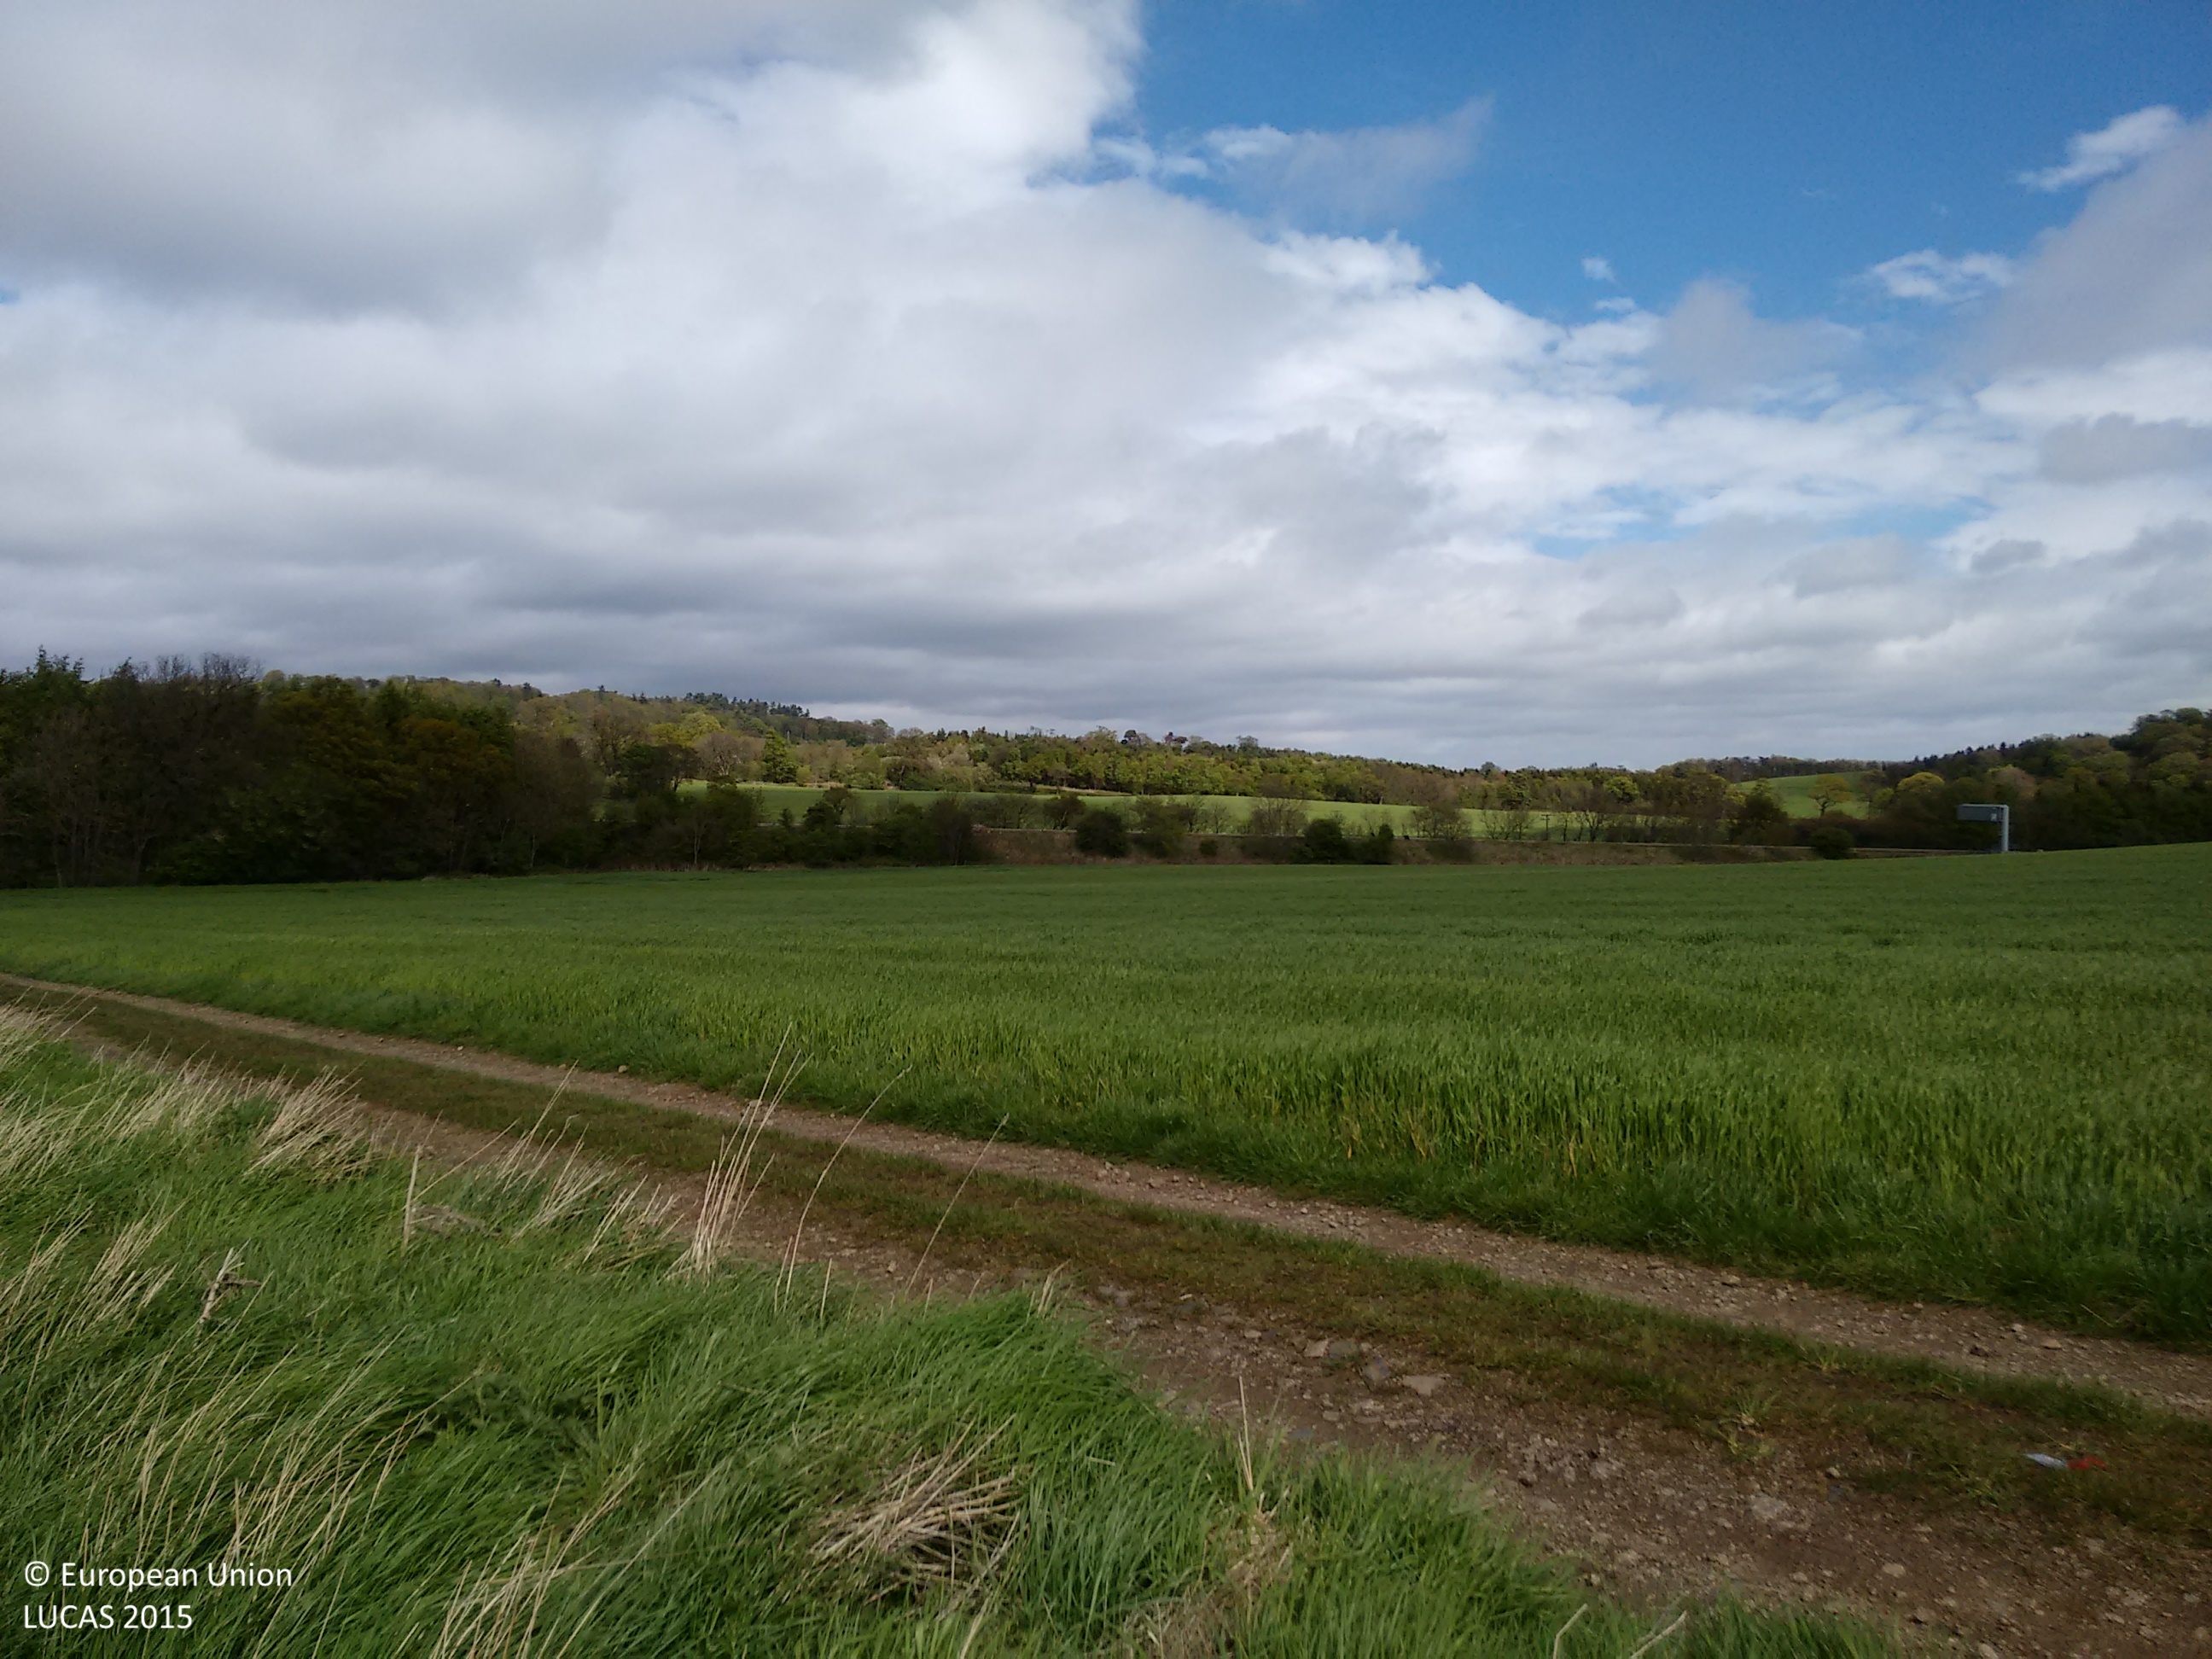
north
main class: Cropland
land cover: Barley
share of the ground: > 75 %
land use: Agriculture (excluding fallow land and kitchen gardens)
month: May
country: GB
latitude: 55.9778
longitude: -3.3597
